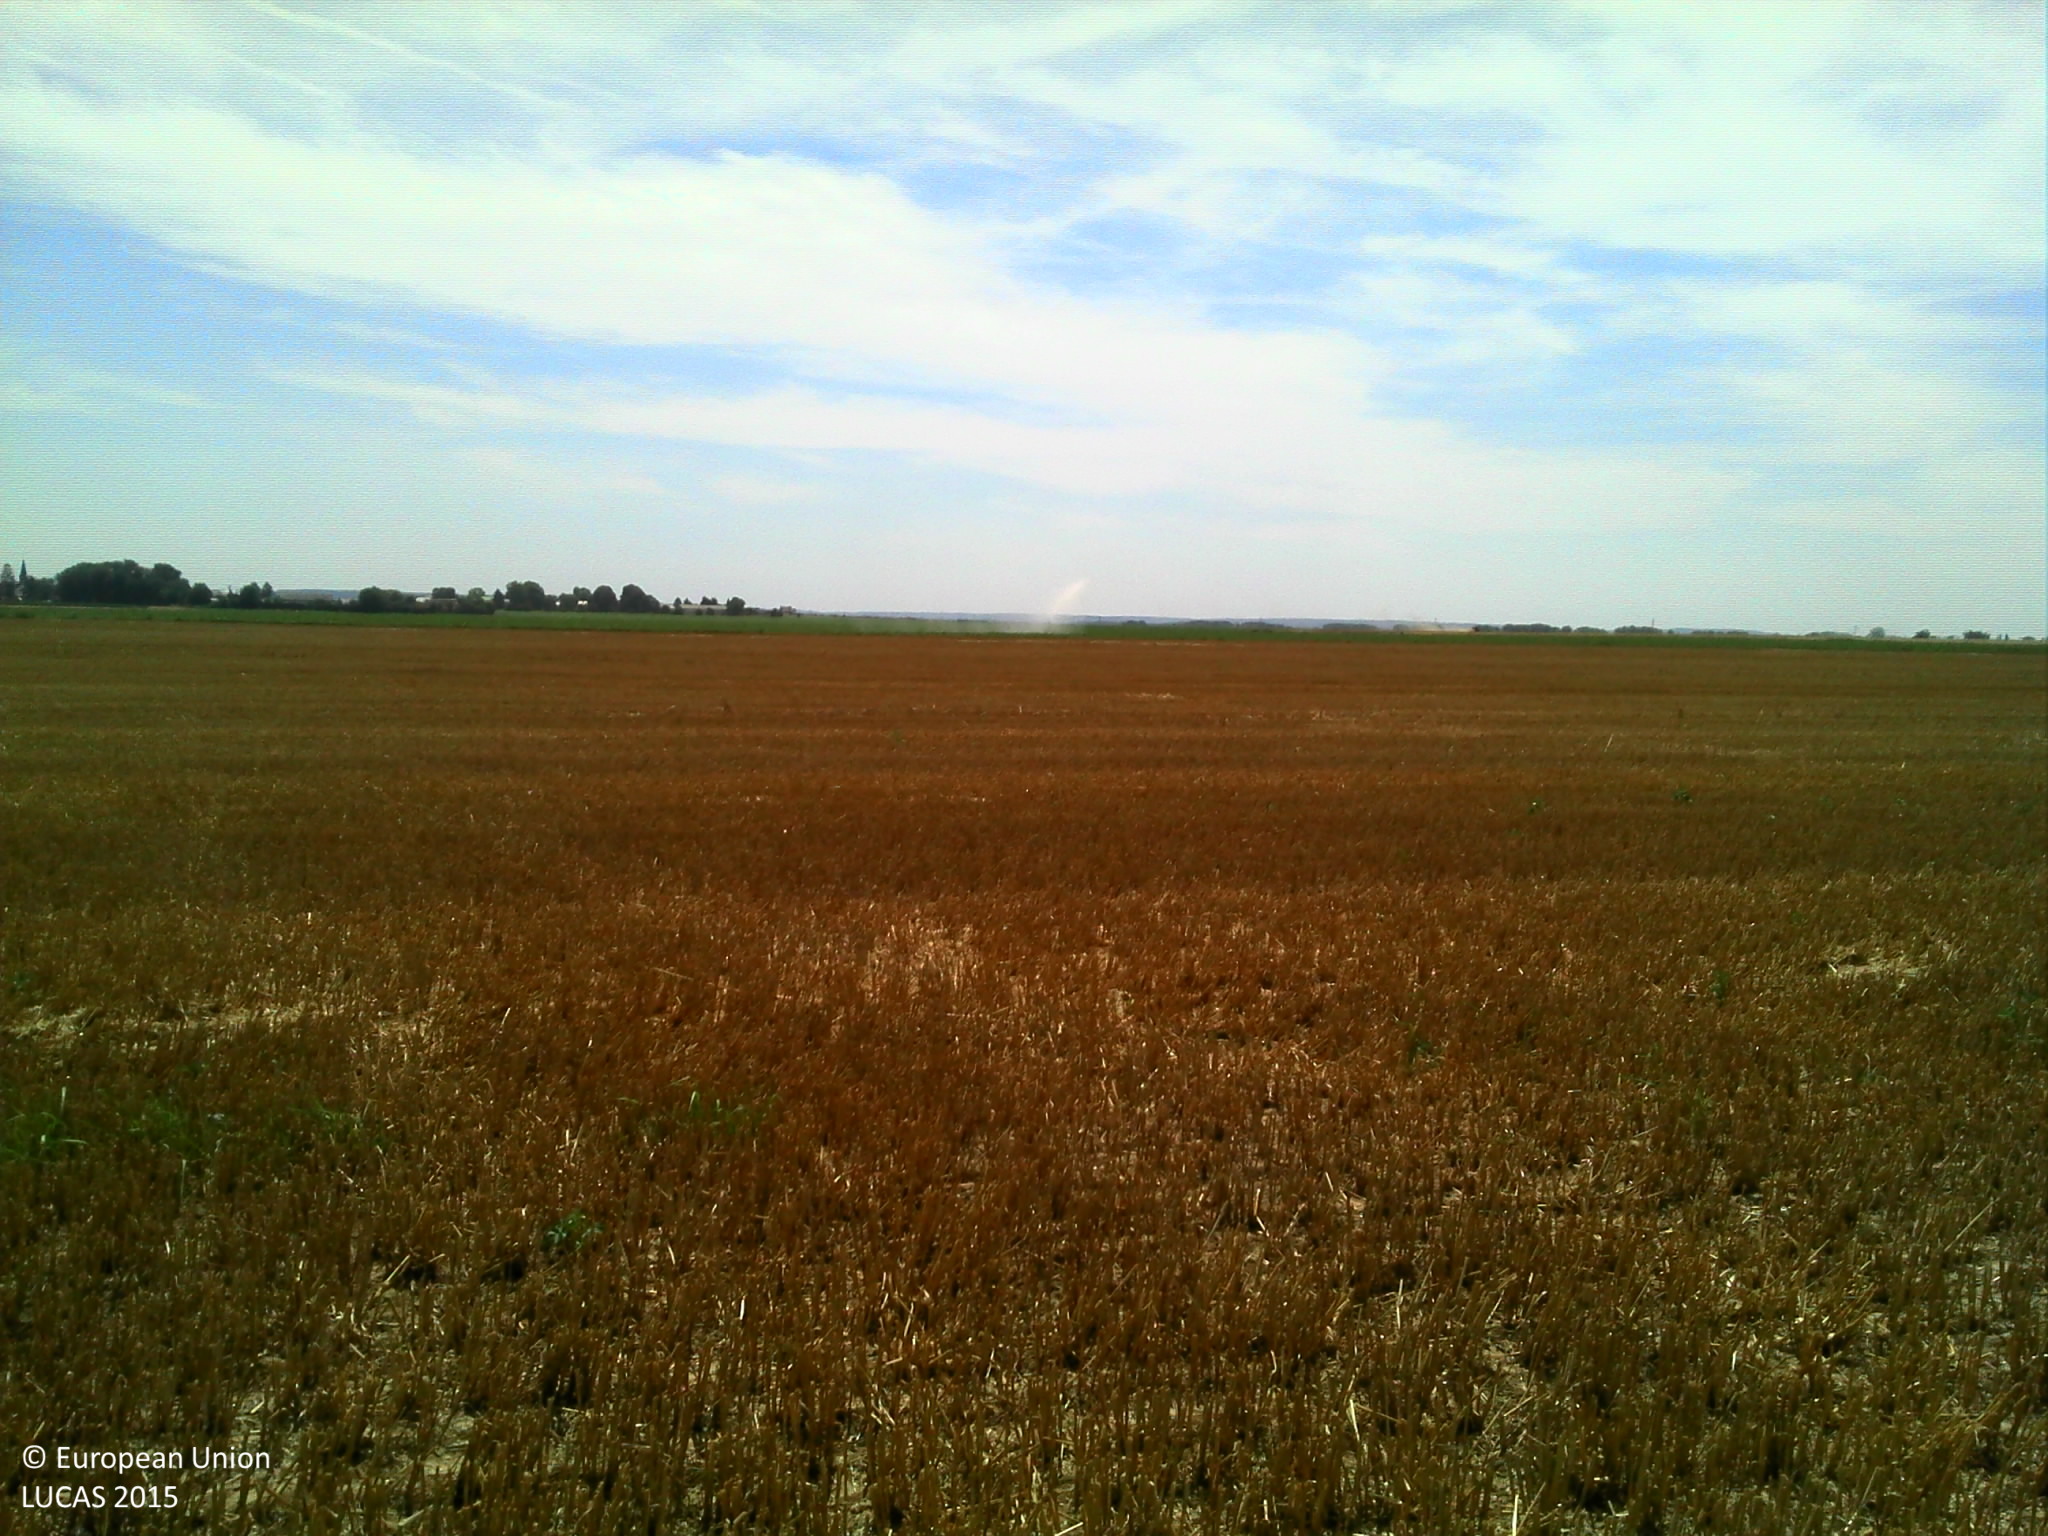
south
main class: Cropland
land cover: Common wheat
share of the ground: > 75 %
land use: Agriculture (excluding fallow land and kitchen gardens)
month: August
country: FR
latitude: 49.7068
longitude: 2.8483
